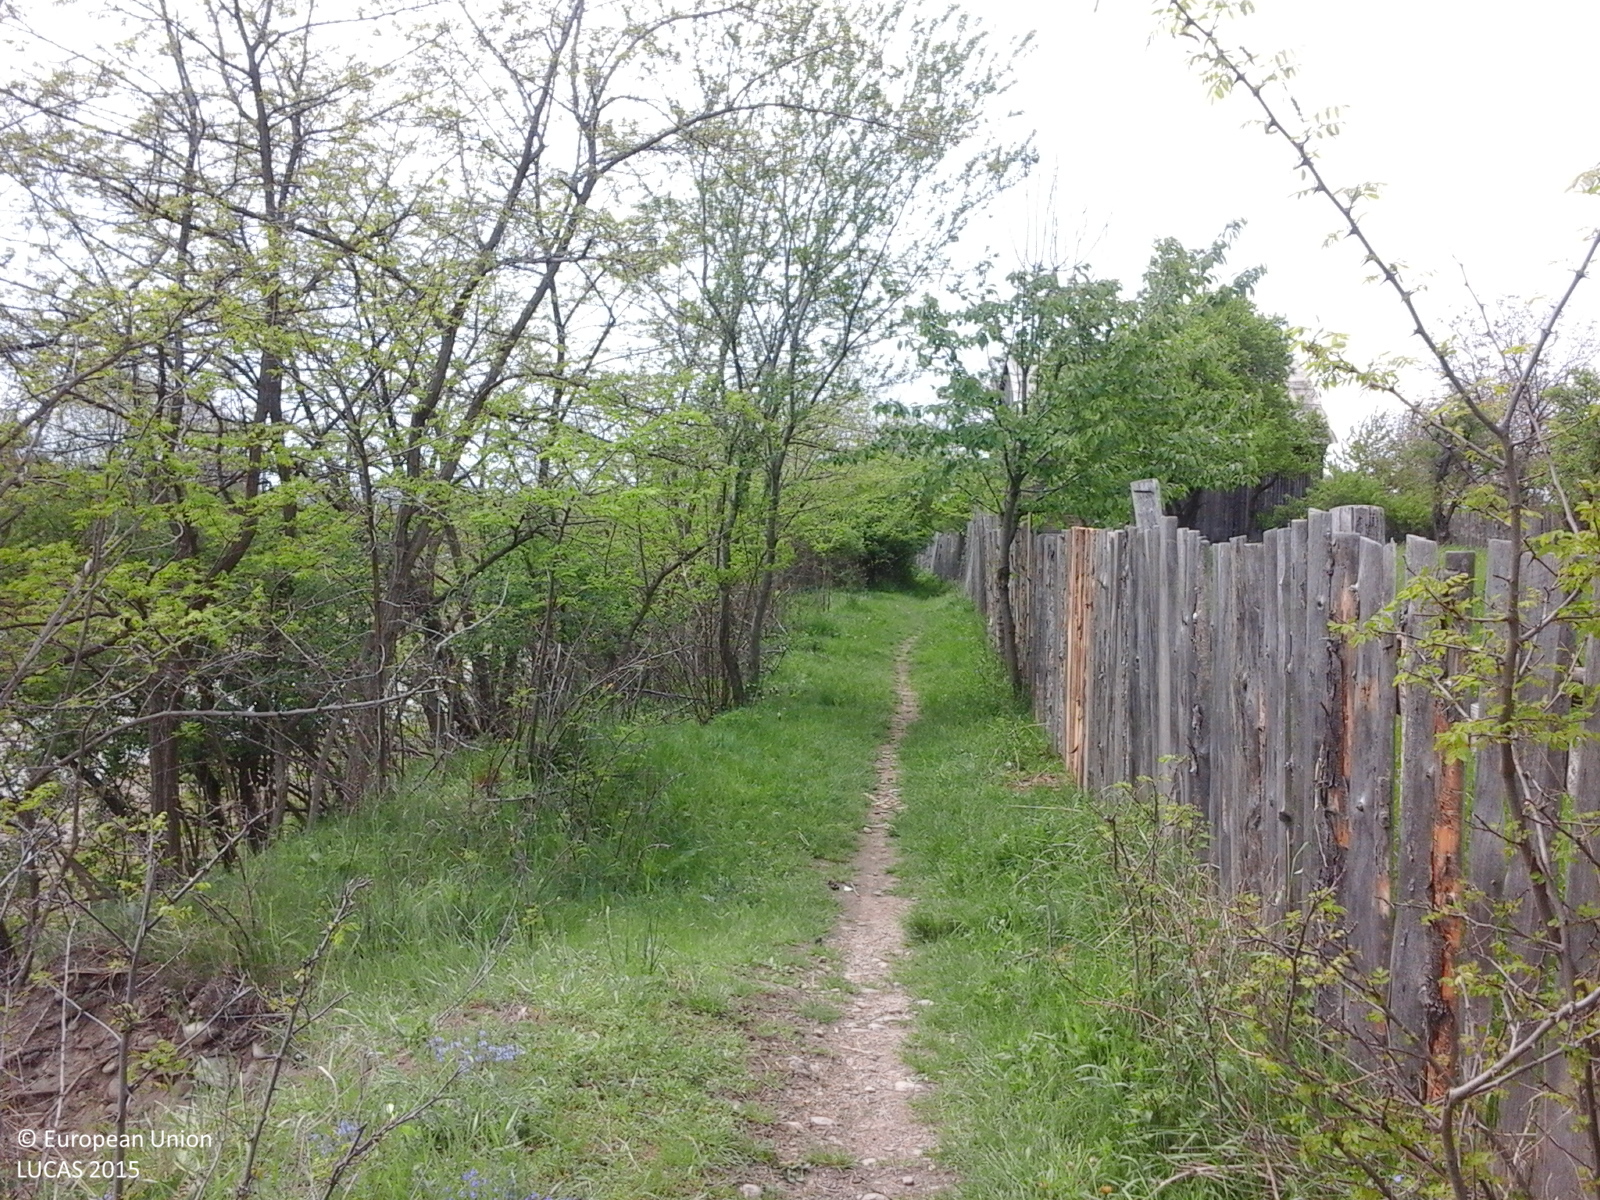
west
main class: Woodland
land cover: Broadleaved woodland
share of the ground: 50 - 75 %
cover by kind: broadleaved forest trees 100 %
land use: Residential
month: May
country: RO
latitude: 45.9449
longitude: 26.2342
